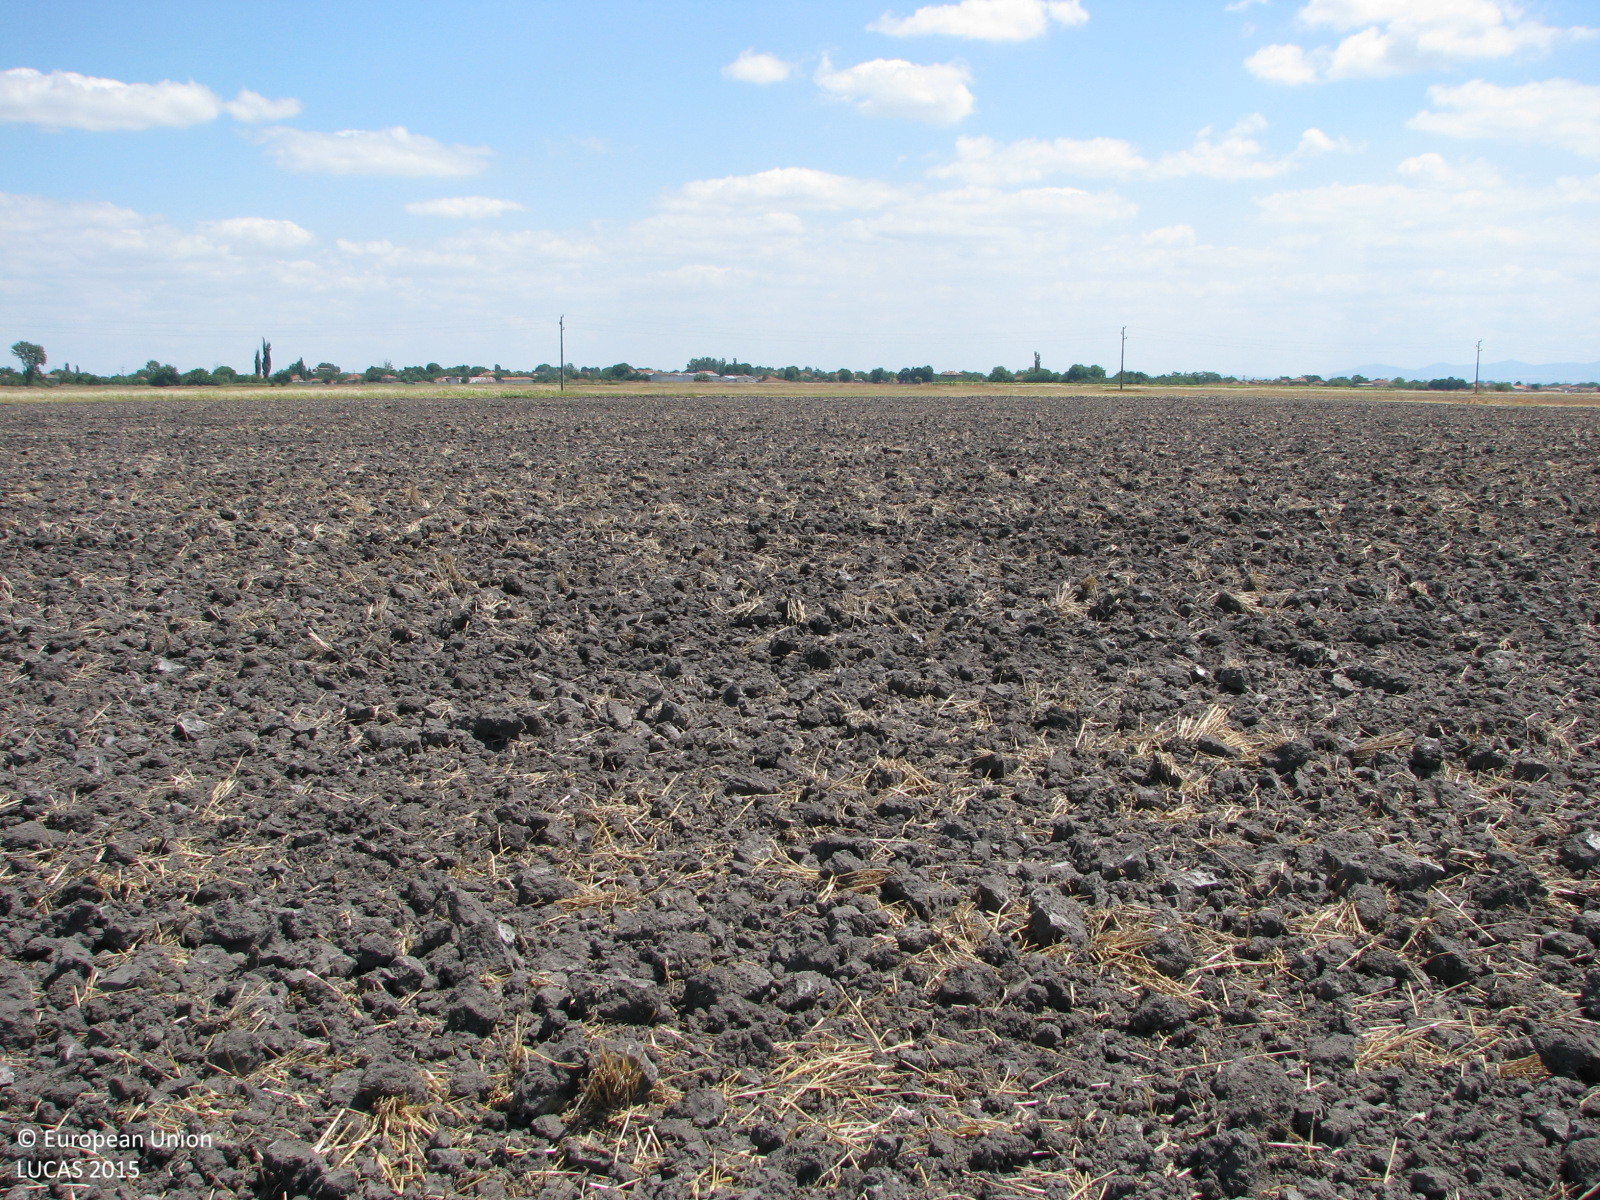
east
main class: Cropland
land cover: Common wheat
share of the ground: < 10 %
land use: Agriculture (excluding fallow land and kitchen gardens)
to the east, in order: Common wheat; Dry pulses; Electric lines; Dry pulses; Lucerne
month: July
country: BG
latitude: 42.6020
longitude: 26.4617
